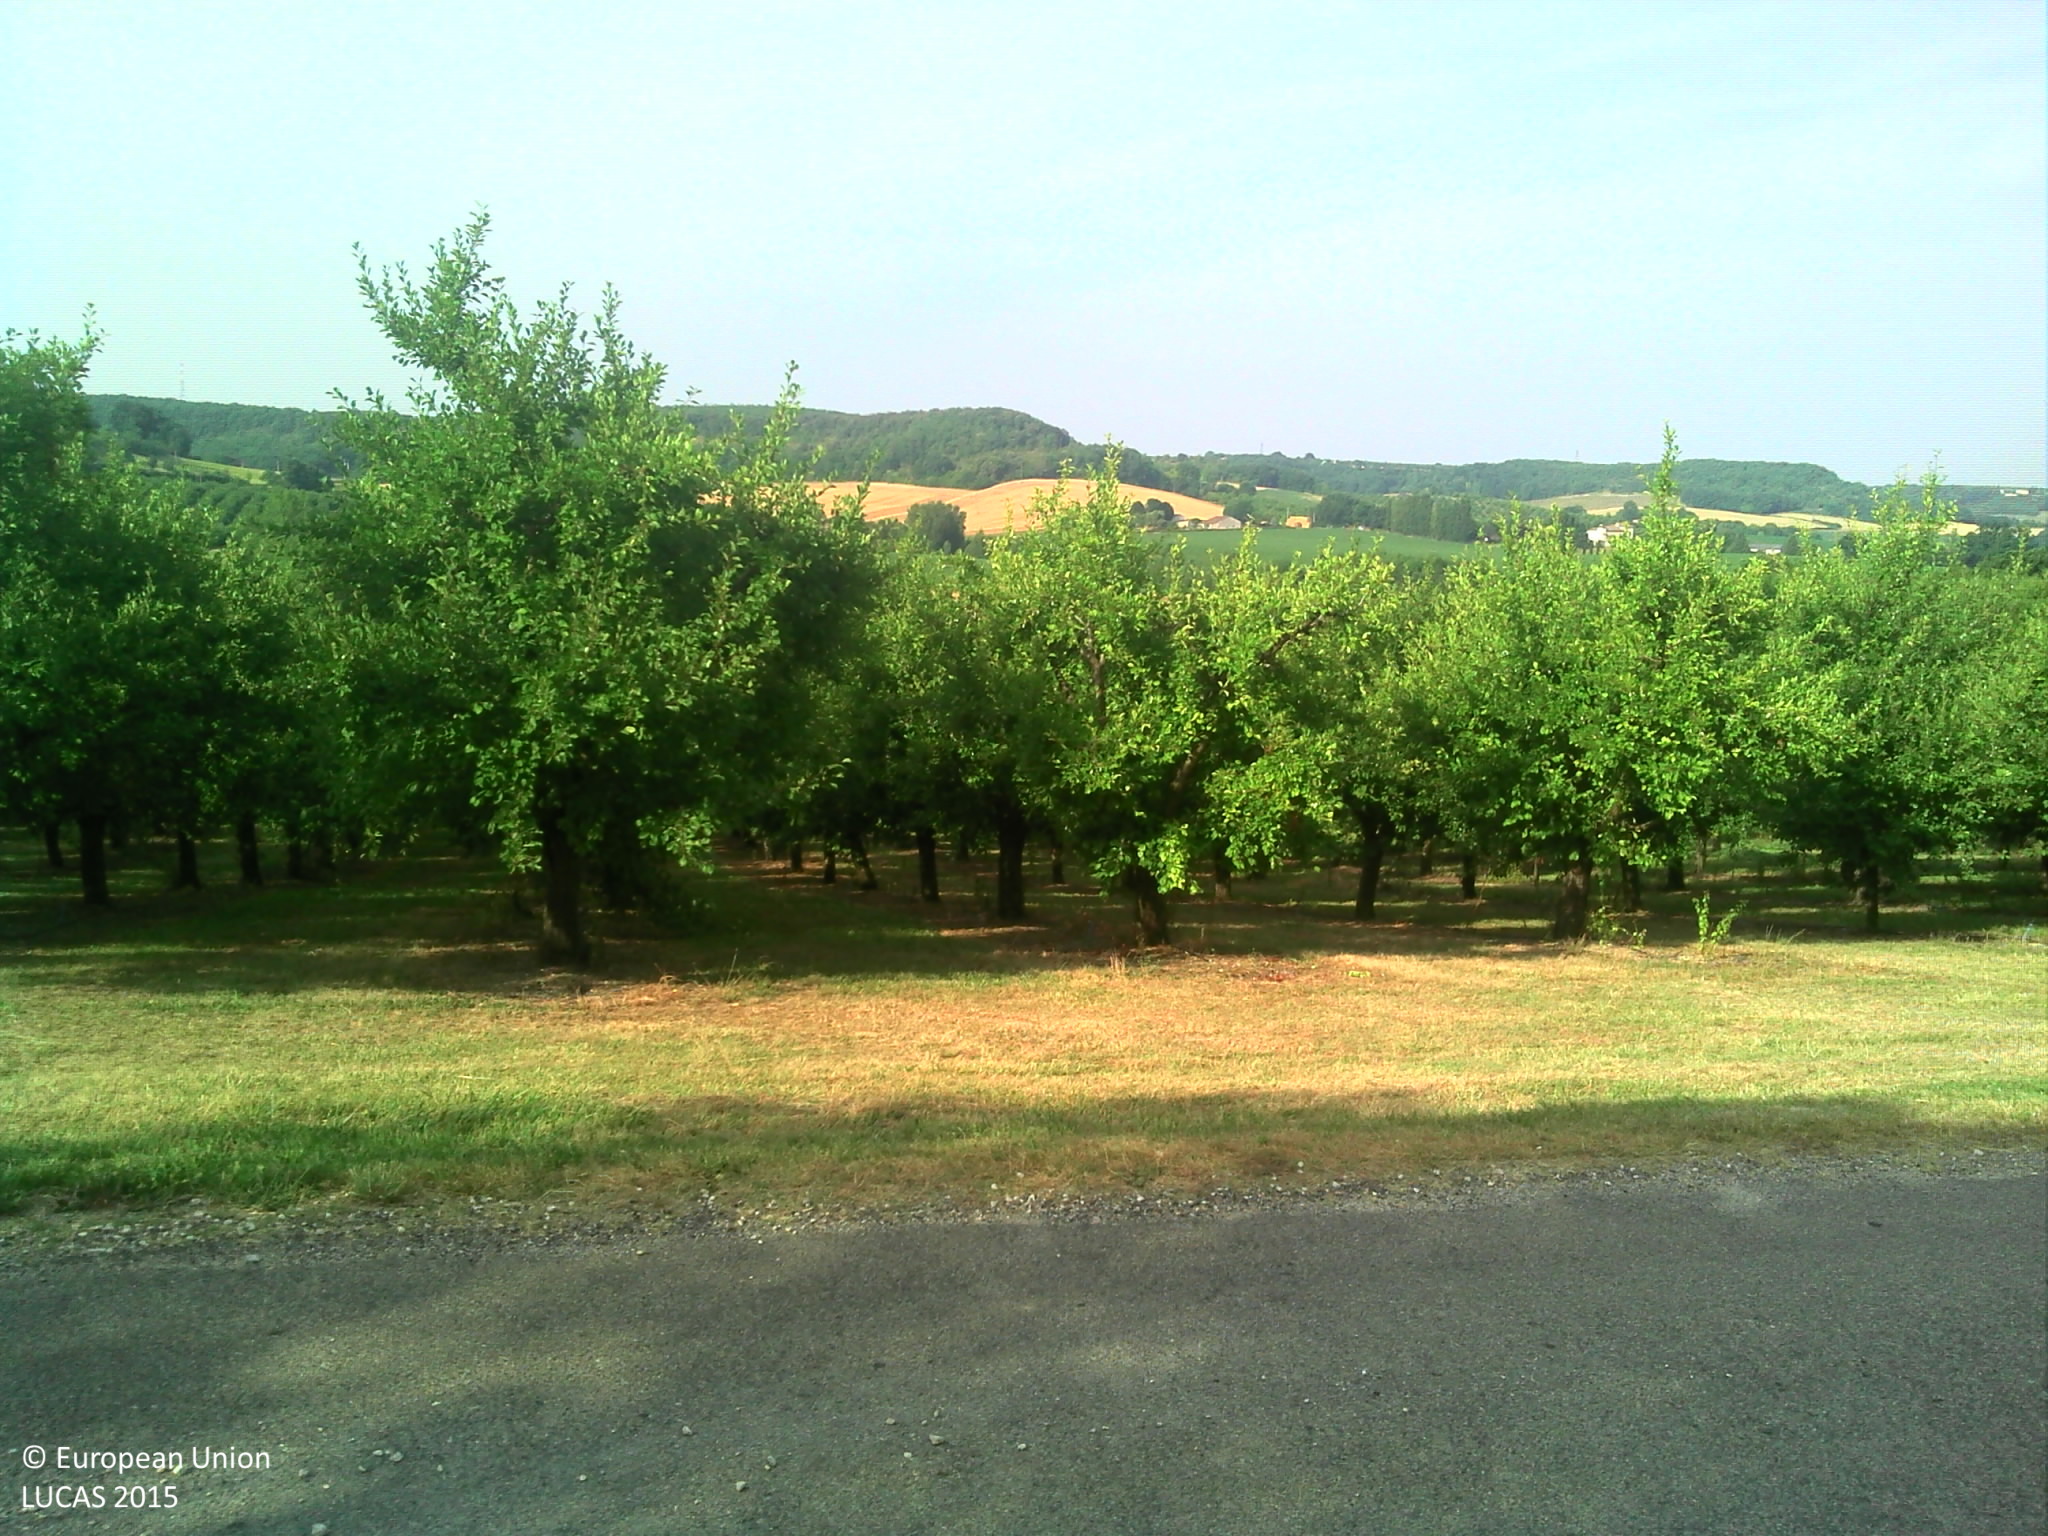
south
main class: Grassland
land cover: Grassland without tree/shrub cover
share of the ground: > 75 %
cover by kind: herbaceous plants 100 %
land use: Agriculture (excluding fallow land and kitchen gardens)
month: July
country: FR
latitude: 44.3692
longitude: 0.9228
